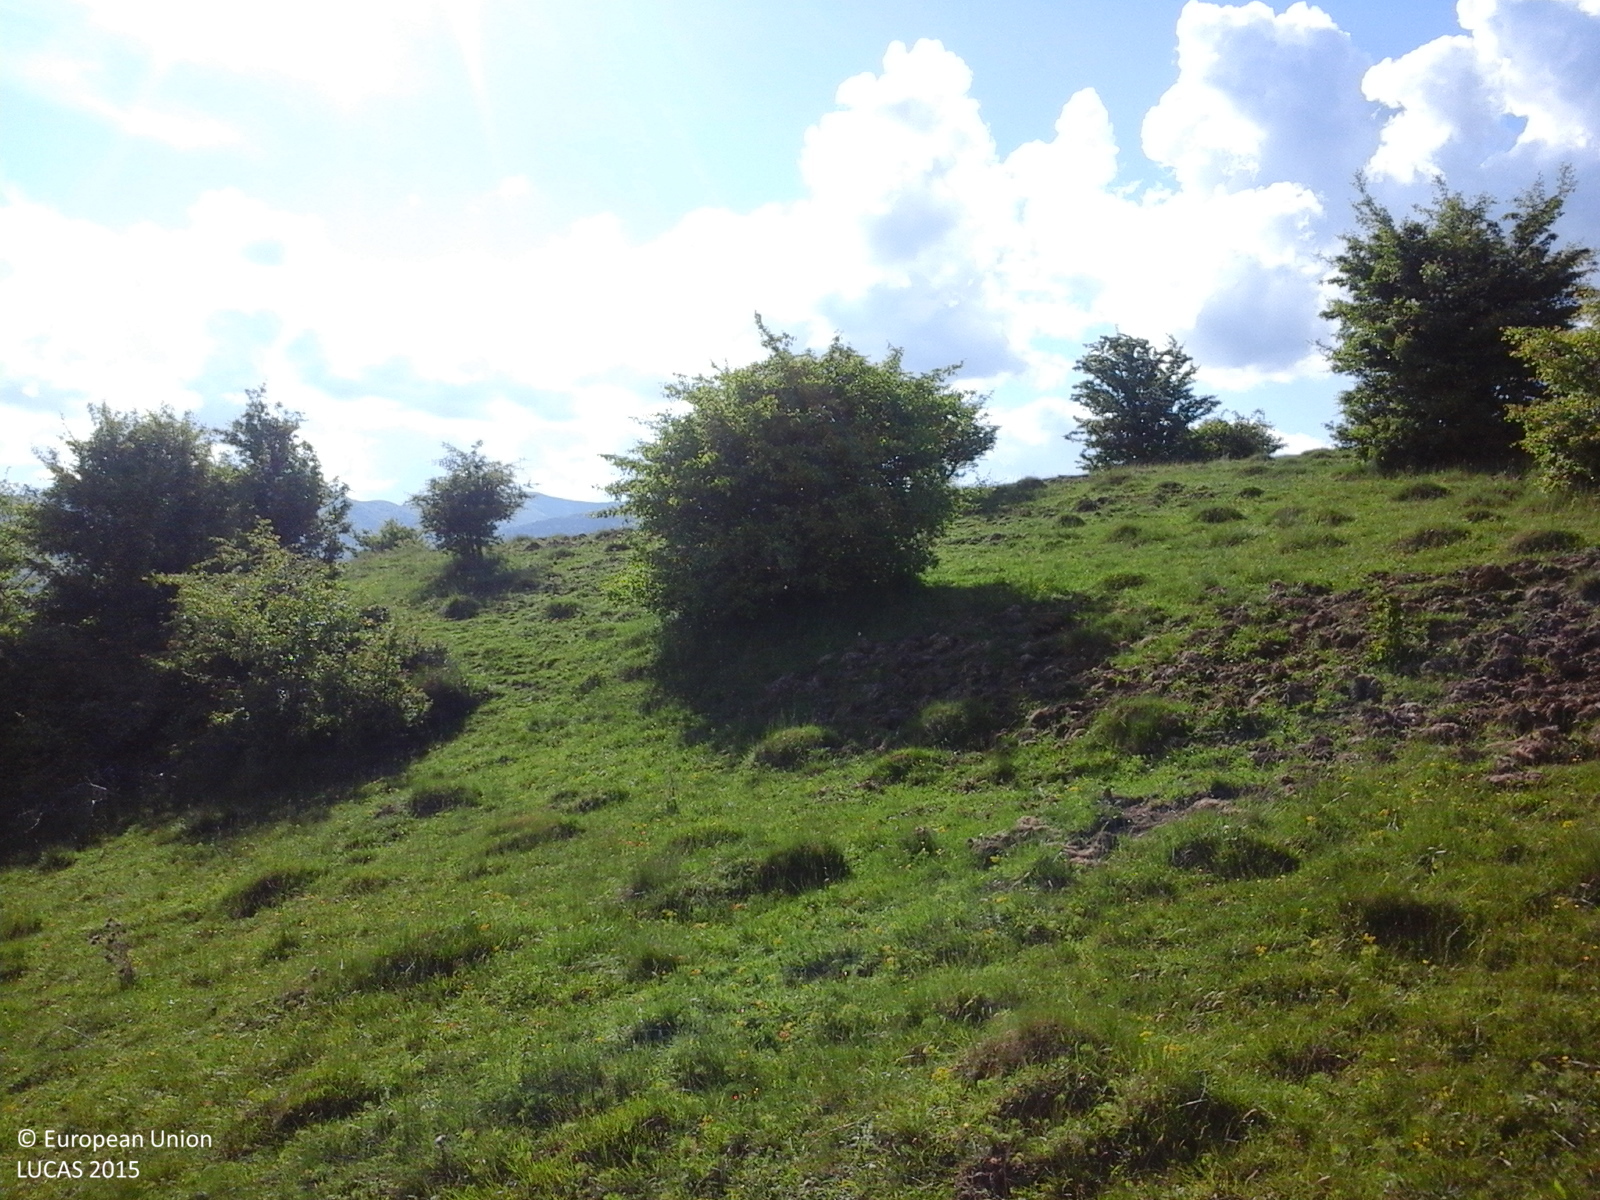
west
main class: Grassland
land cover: Grassland with sparse tree/shrub cover
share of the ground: > 75 %
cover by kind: herbaceous plants 85 %, shrubs 10 %, broadleaved forest trees 5 %
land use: Agriculture (excluding fallow land and kitchen gardens)
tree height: < 5 m
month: May
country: RO
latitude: 45.3105
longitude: 25.7033
